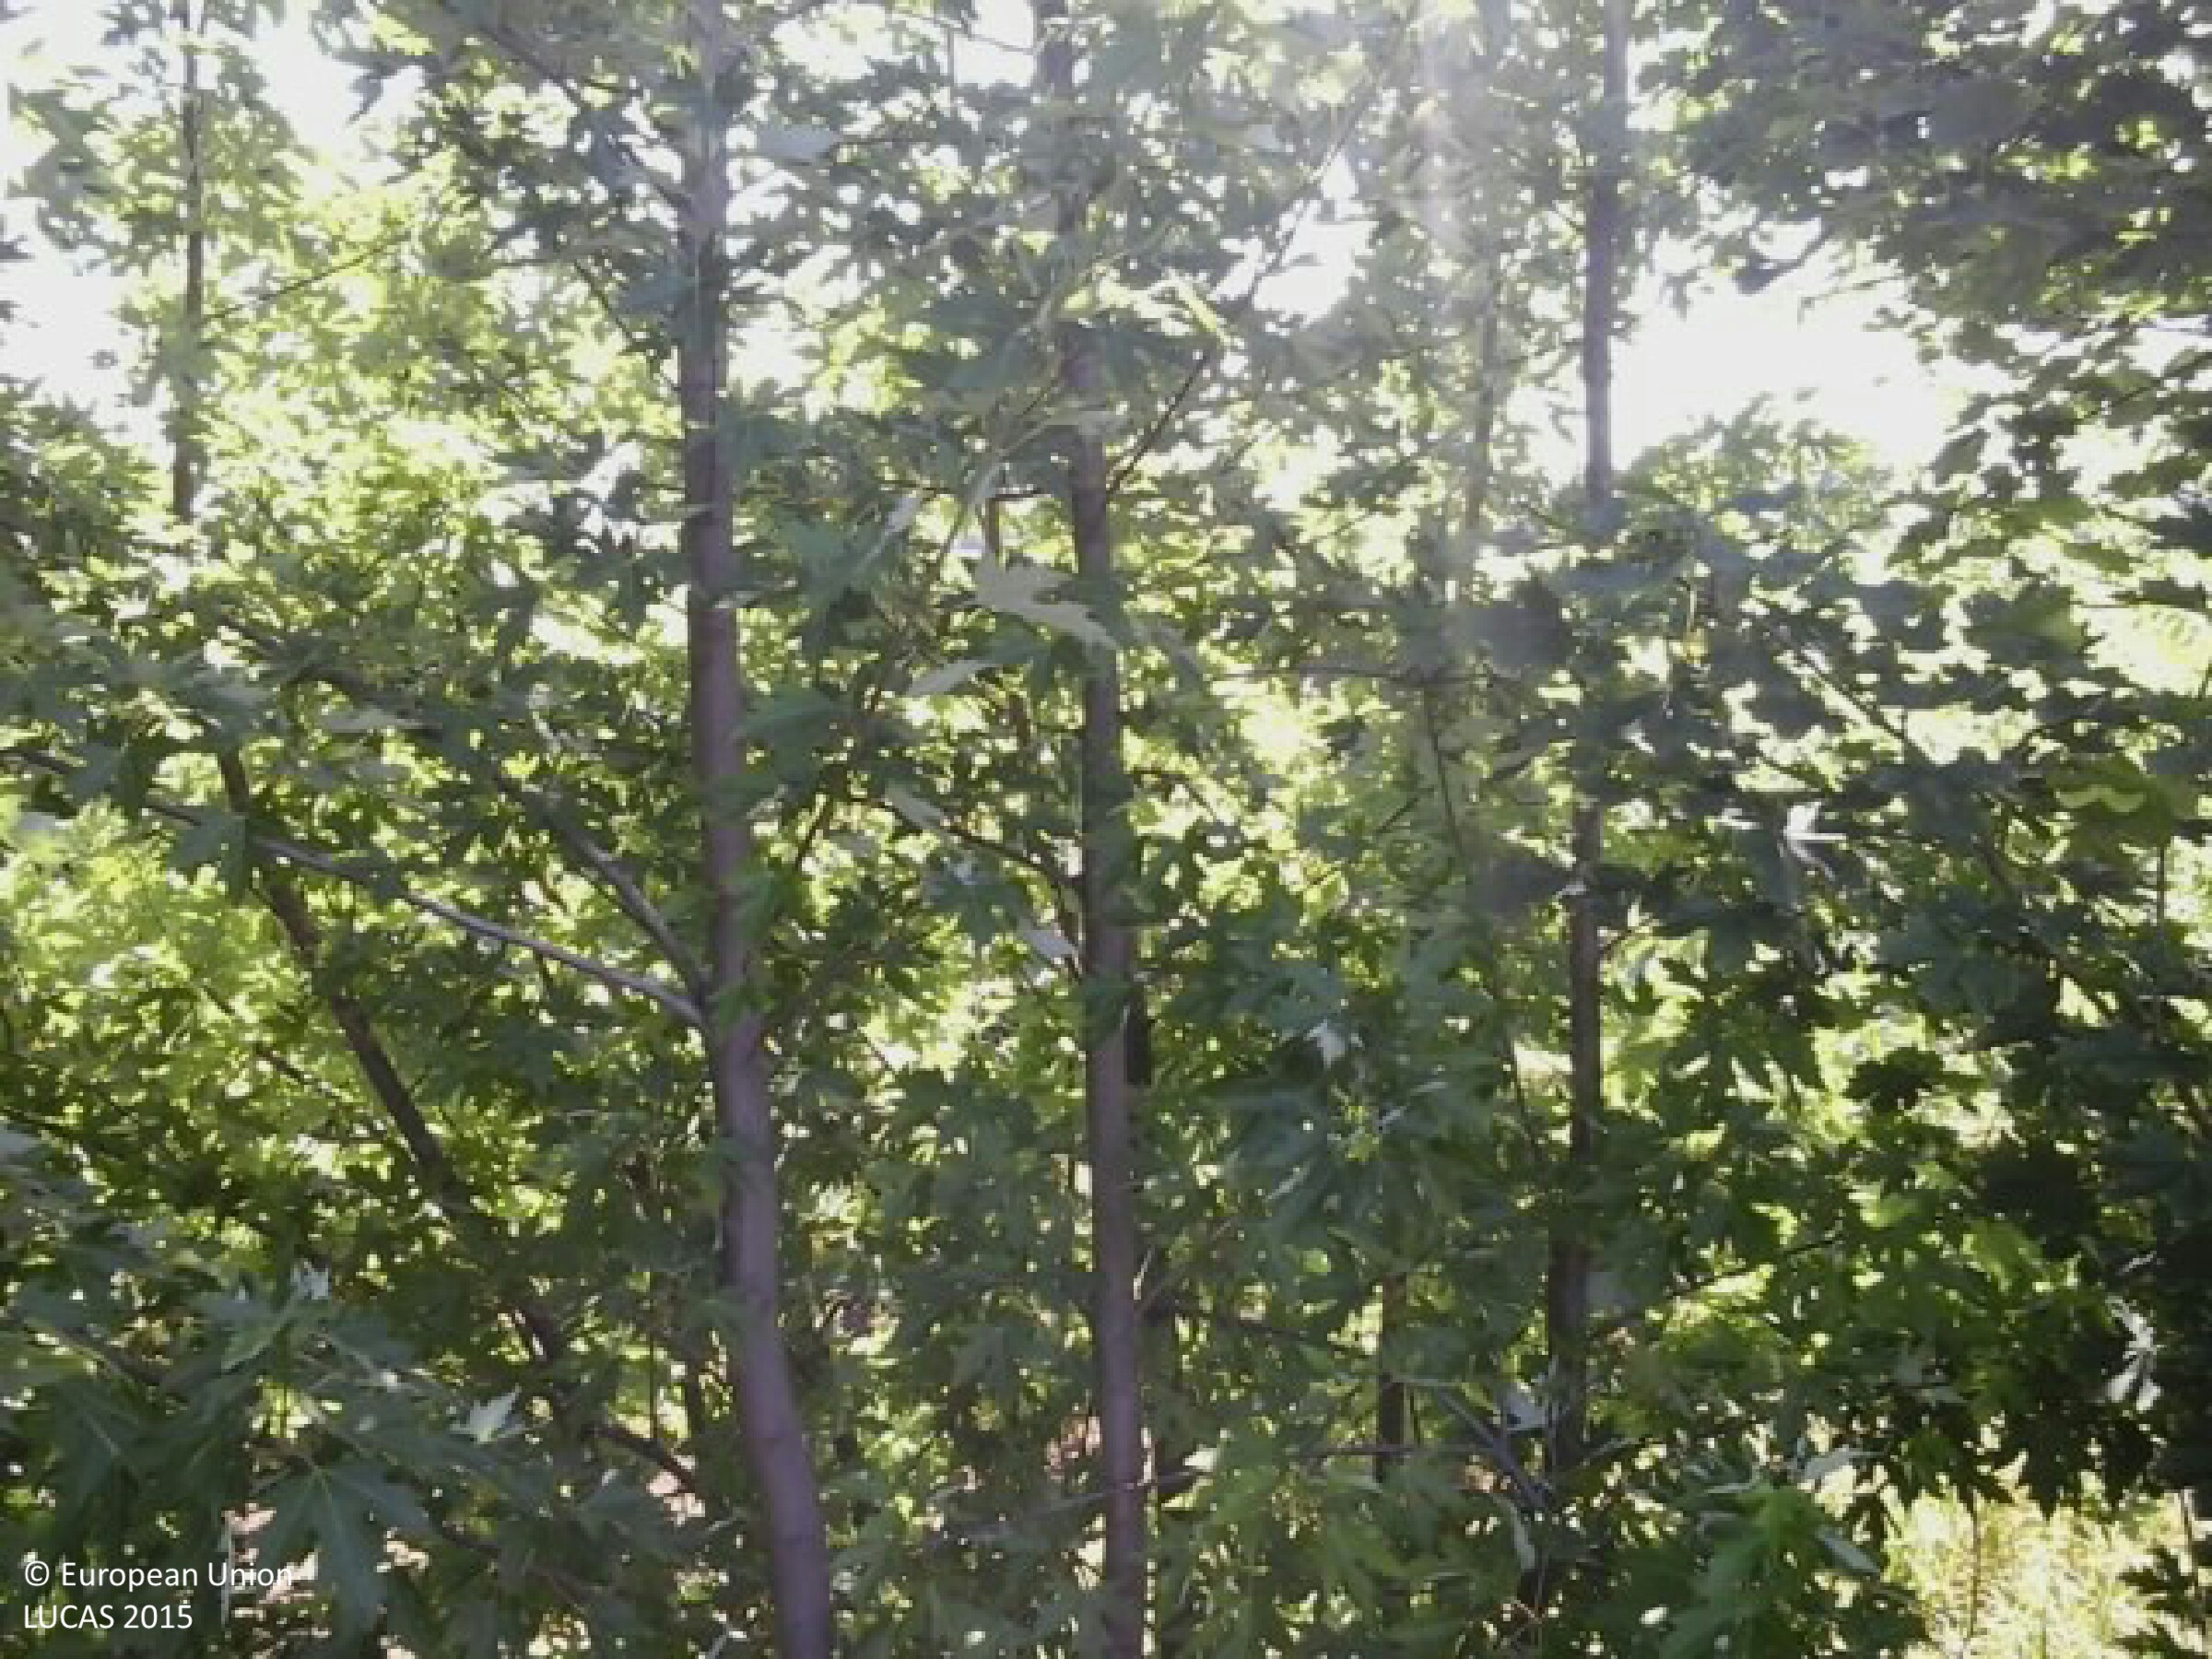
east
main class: Grassland
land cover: Spontaneously vegetated surfaces
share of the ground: > 75 %
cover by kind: herbaceous plants 100 %
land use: Agriculture (excluding fallow land and kitchen gardens)
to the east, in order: Spontaneously vegetated surfaces; Artificial constructions in urban areas; Lines of trees; Sunflower; Lines of trees; Grass margins; Ditches and canals; Grass margins; Paved roads, cycling and walking lanes; Grass margins; Ditches and canals; Common wheat
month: July
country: HU
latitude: 48.2620
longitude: 20.7189
